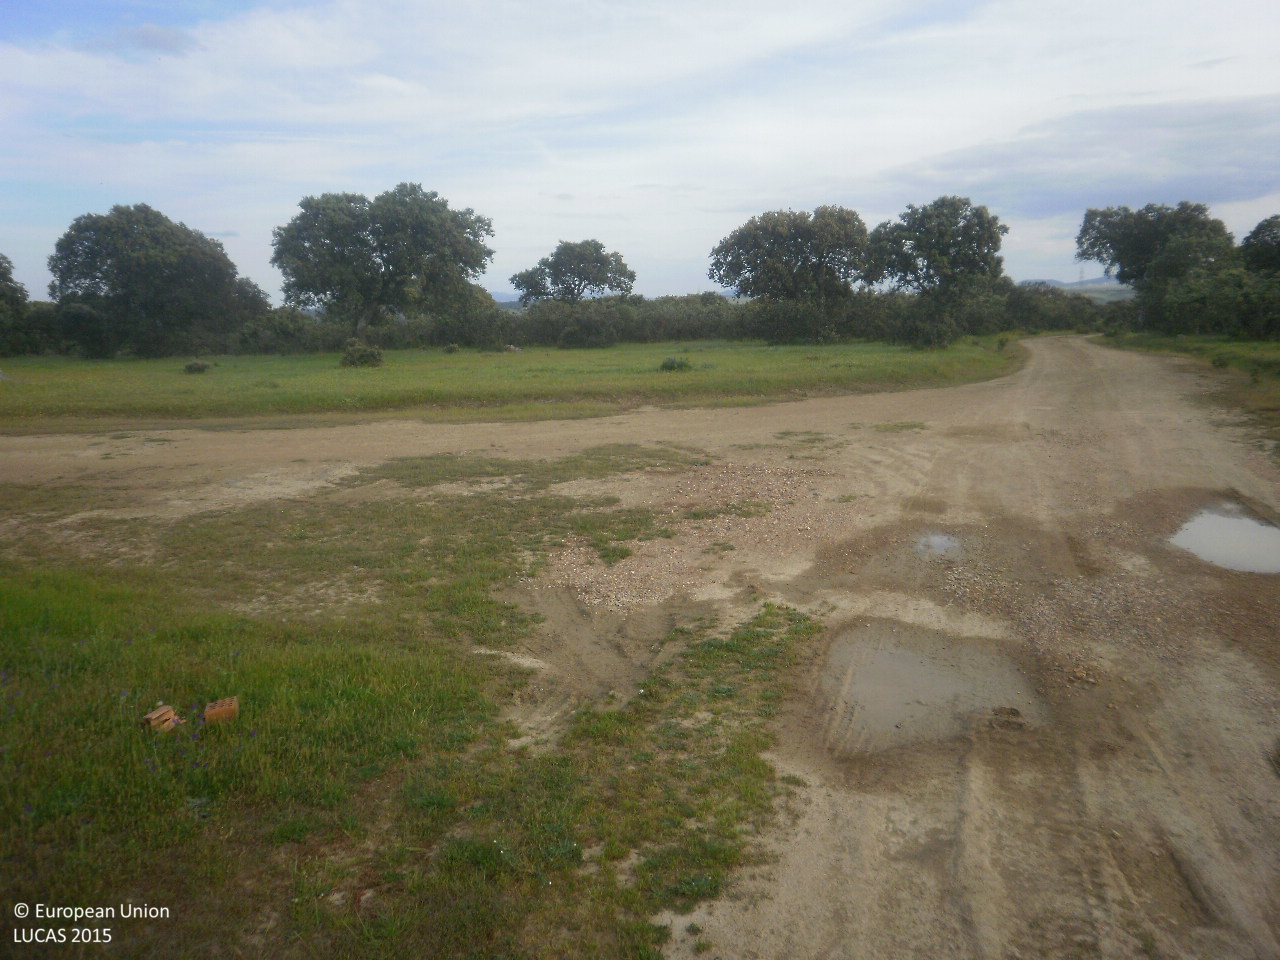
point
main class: Woodland
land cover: Broadleaved woodland
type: broadleaved evergreen forest
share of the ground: 50 - 75 %
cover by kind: broadleaved forest trees 50 %, shrubs 35 %, herbaceous plants 15 %
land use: Agriculture (excluding fallow land and kitchen gardens)
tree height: > 5 m
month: April
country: ES
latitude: 39.1185
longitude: -5.2744
